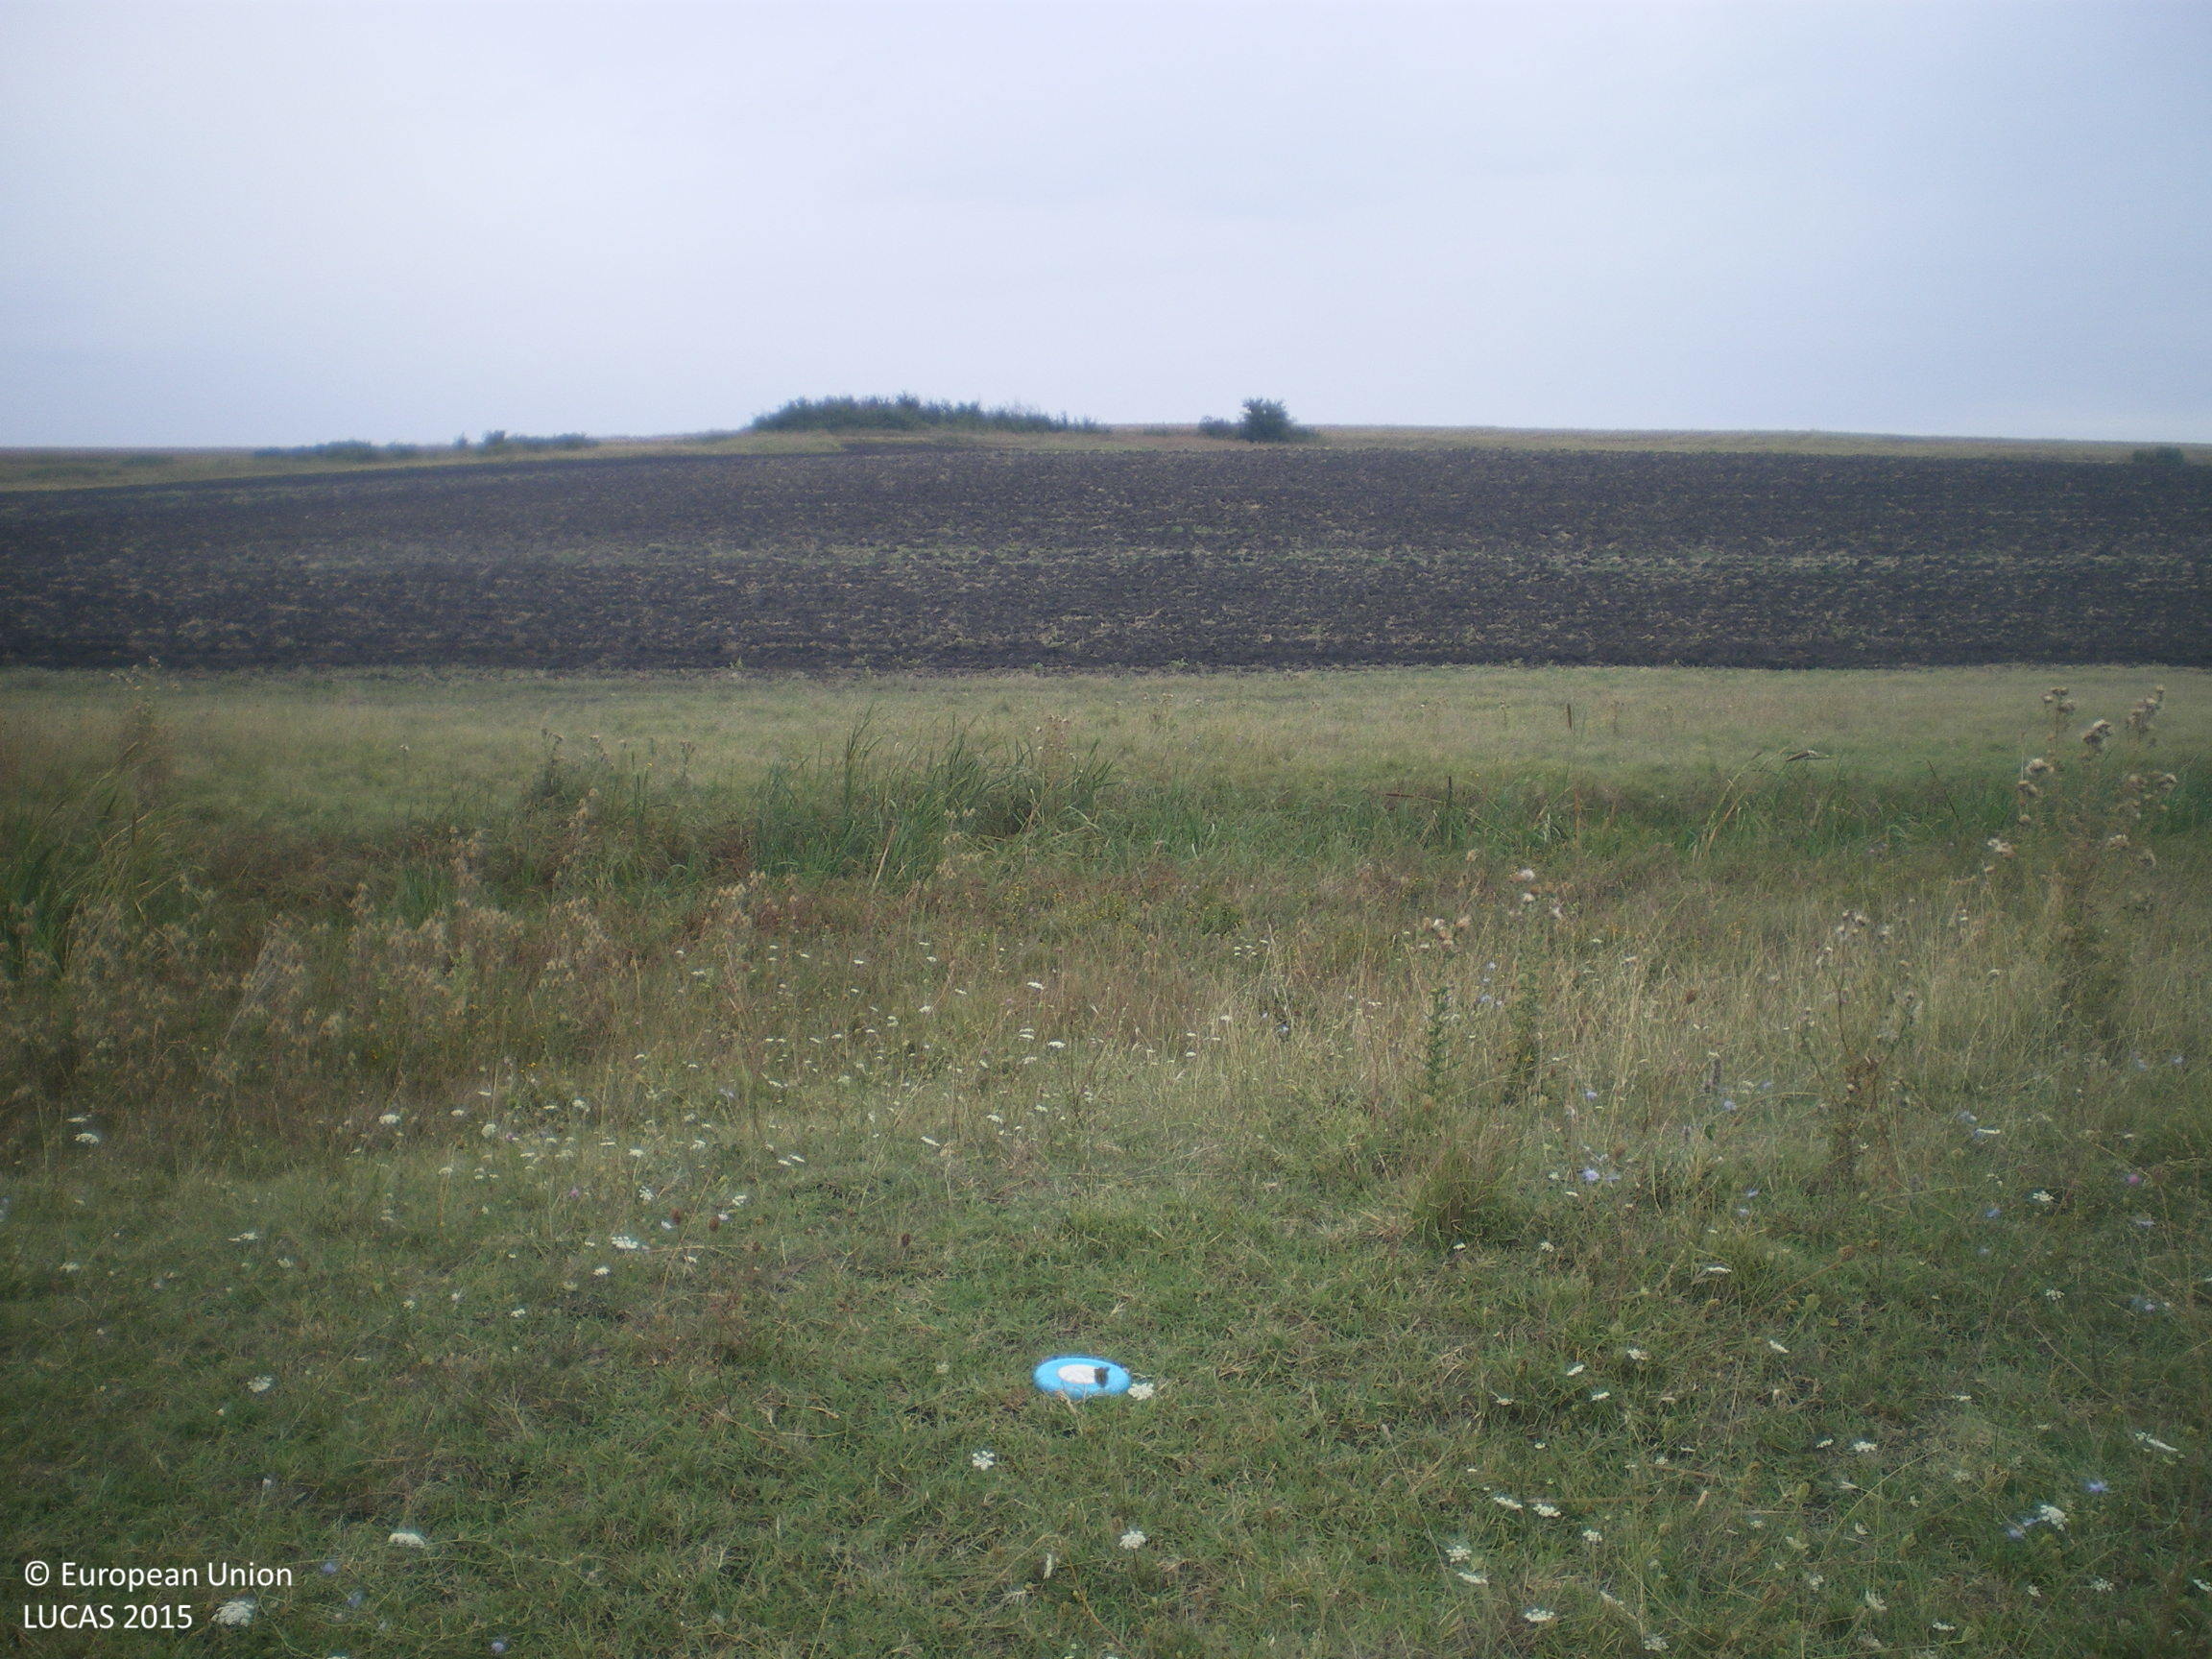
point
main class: Grassland
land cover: Grassland without tree/shrub cover
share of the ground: > 75 %
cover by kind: herbaceous plants 100 %
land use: Agriculture (excluding fallow land and kitchen gardens)
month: September
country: BG
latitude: 42.2356
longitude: 25.8885
